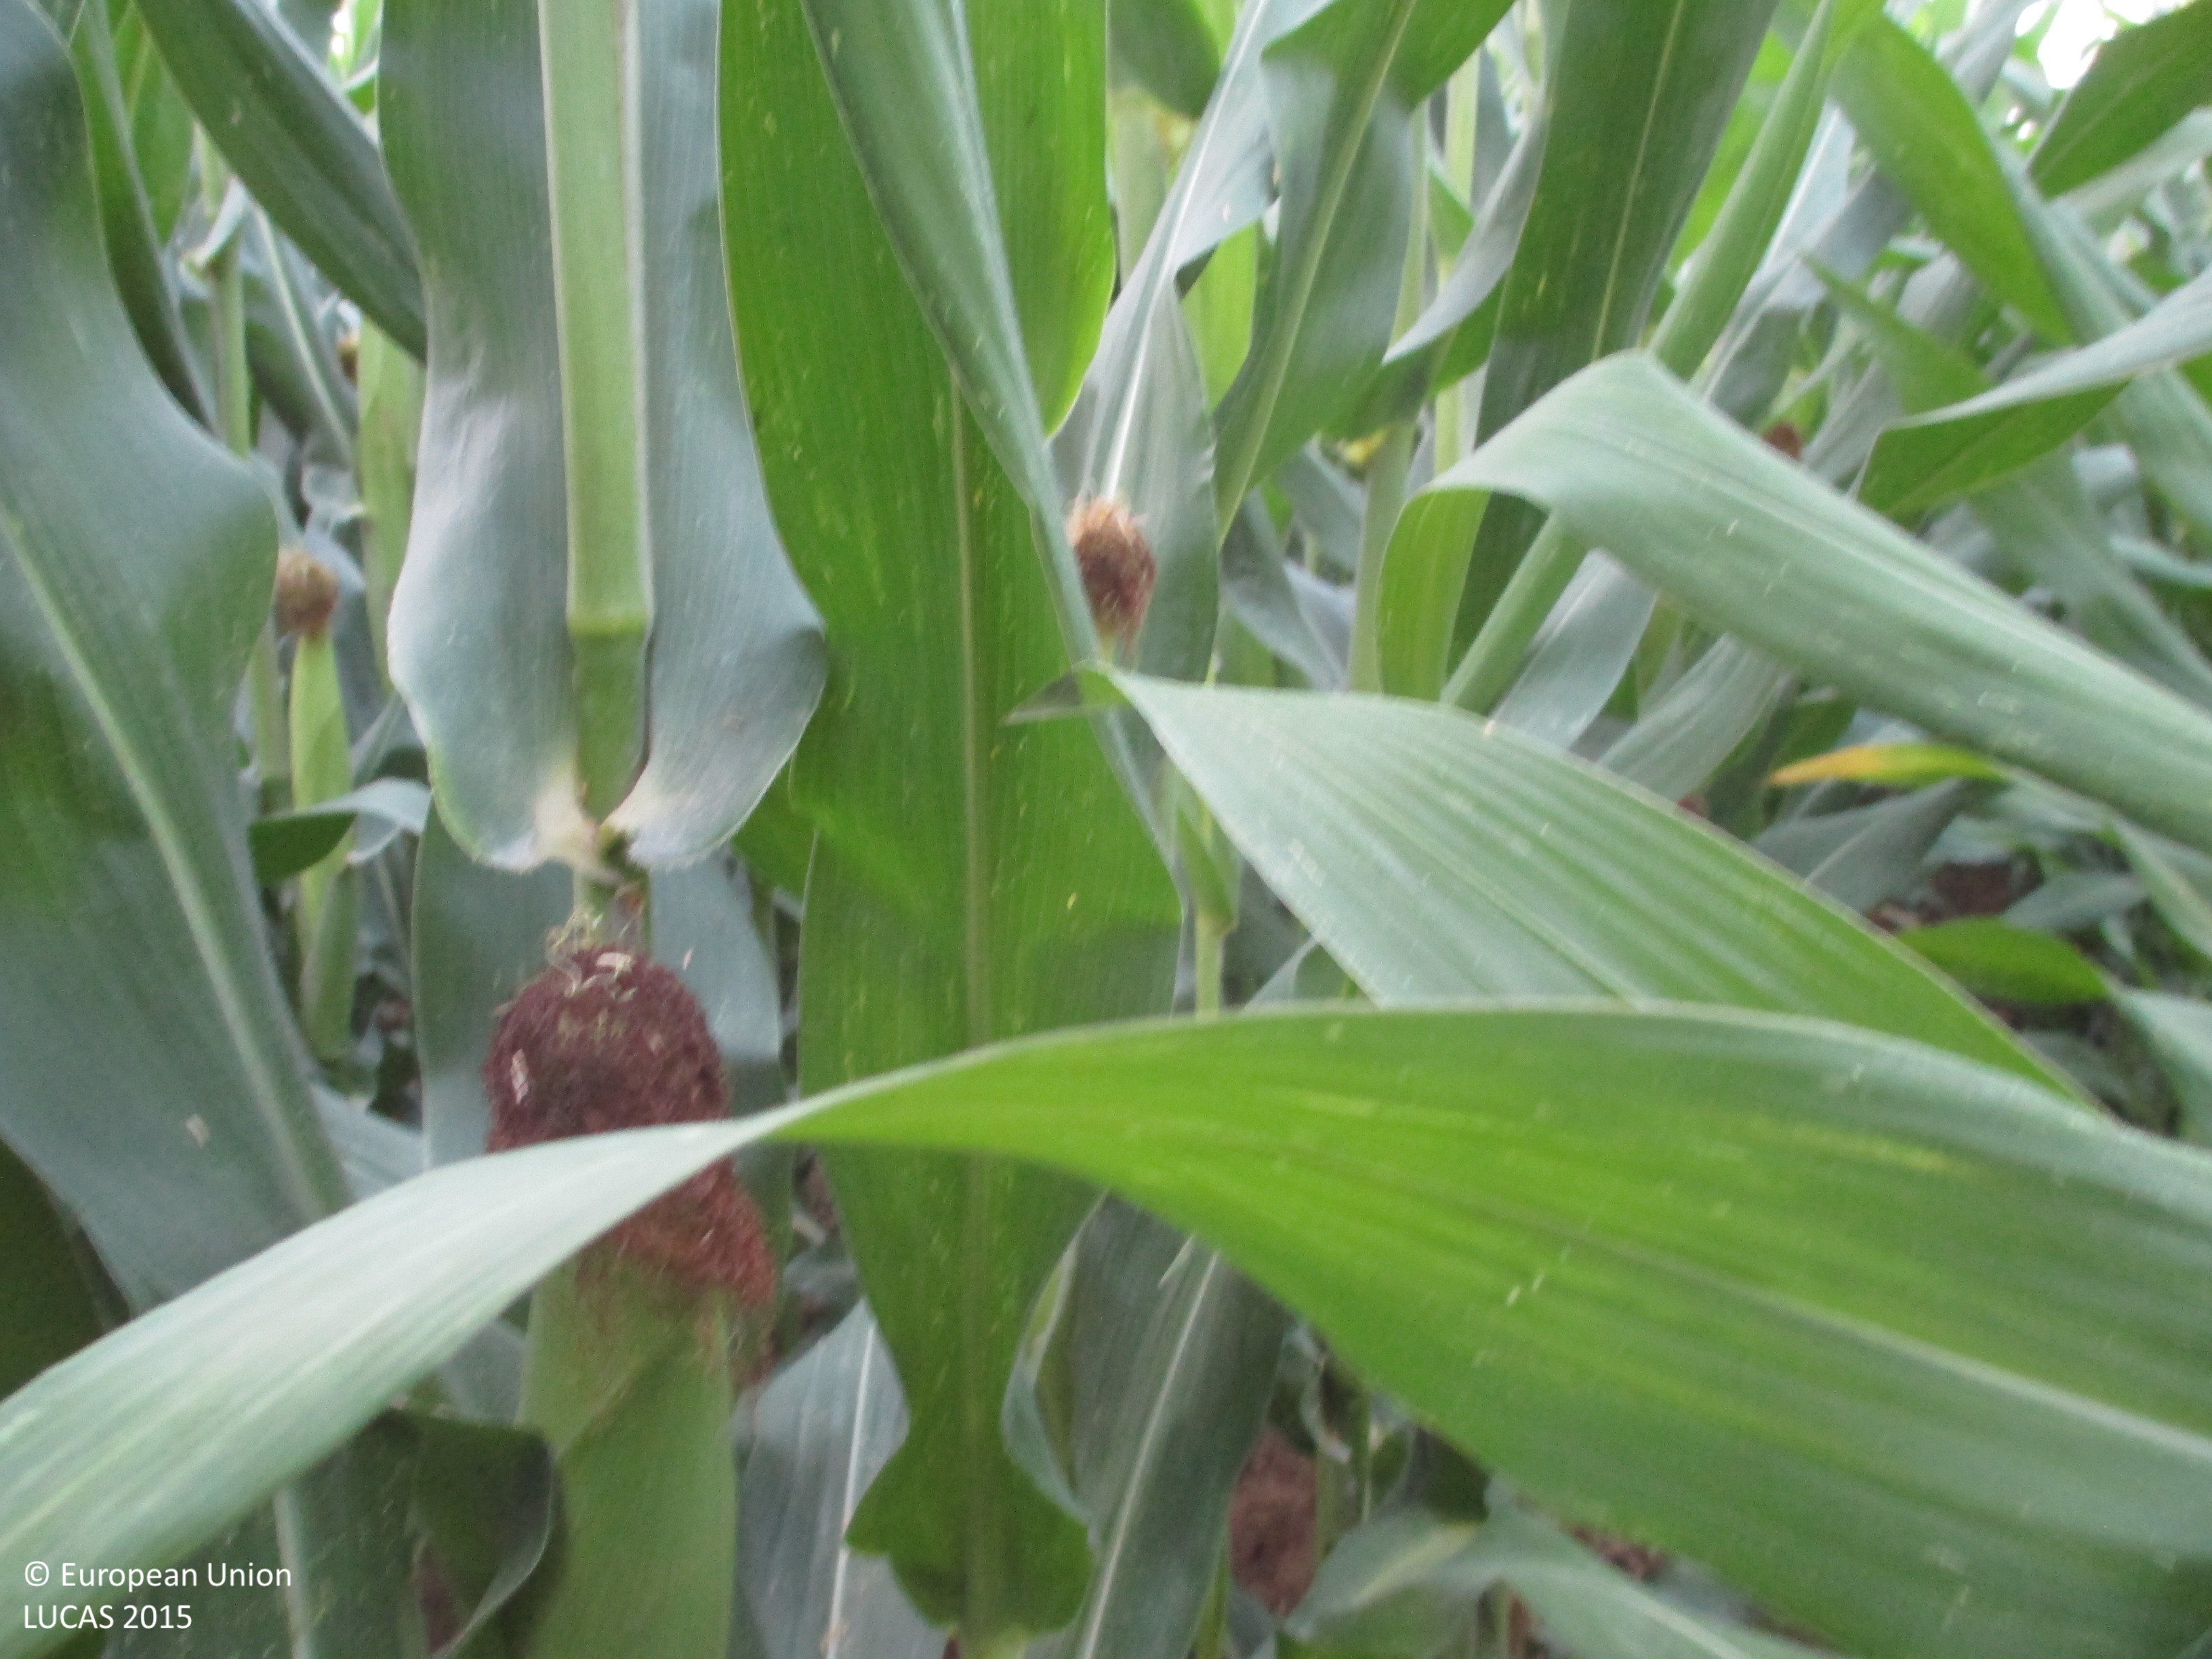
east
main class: Cropland
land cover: Maize
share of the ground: > 75 %
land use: Agriculture (excluding fallow land and kitchen gardens)
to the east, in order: Maize; Shruby margins; Maize; Shruby margins; Maize; Shruby margins; Maize
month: July
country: ES
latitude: 41.8456
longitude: 0.3374
